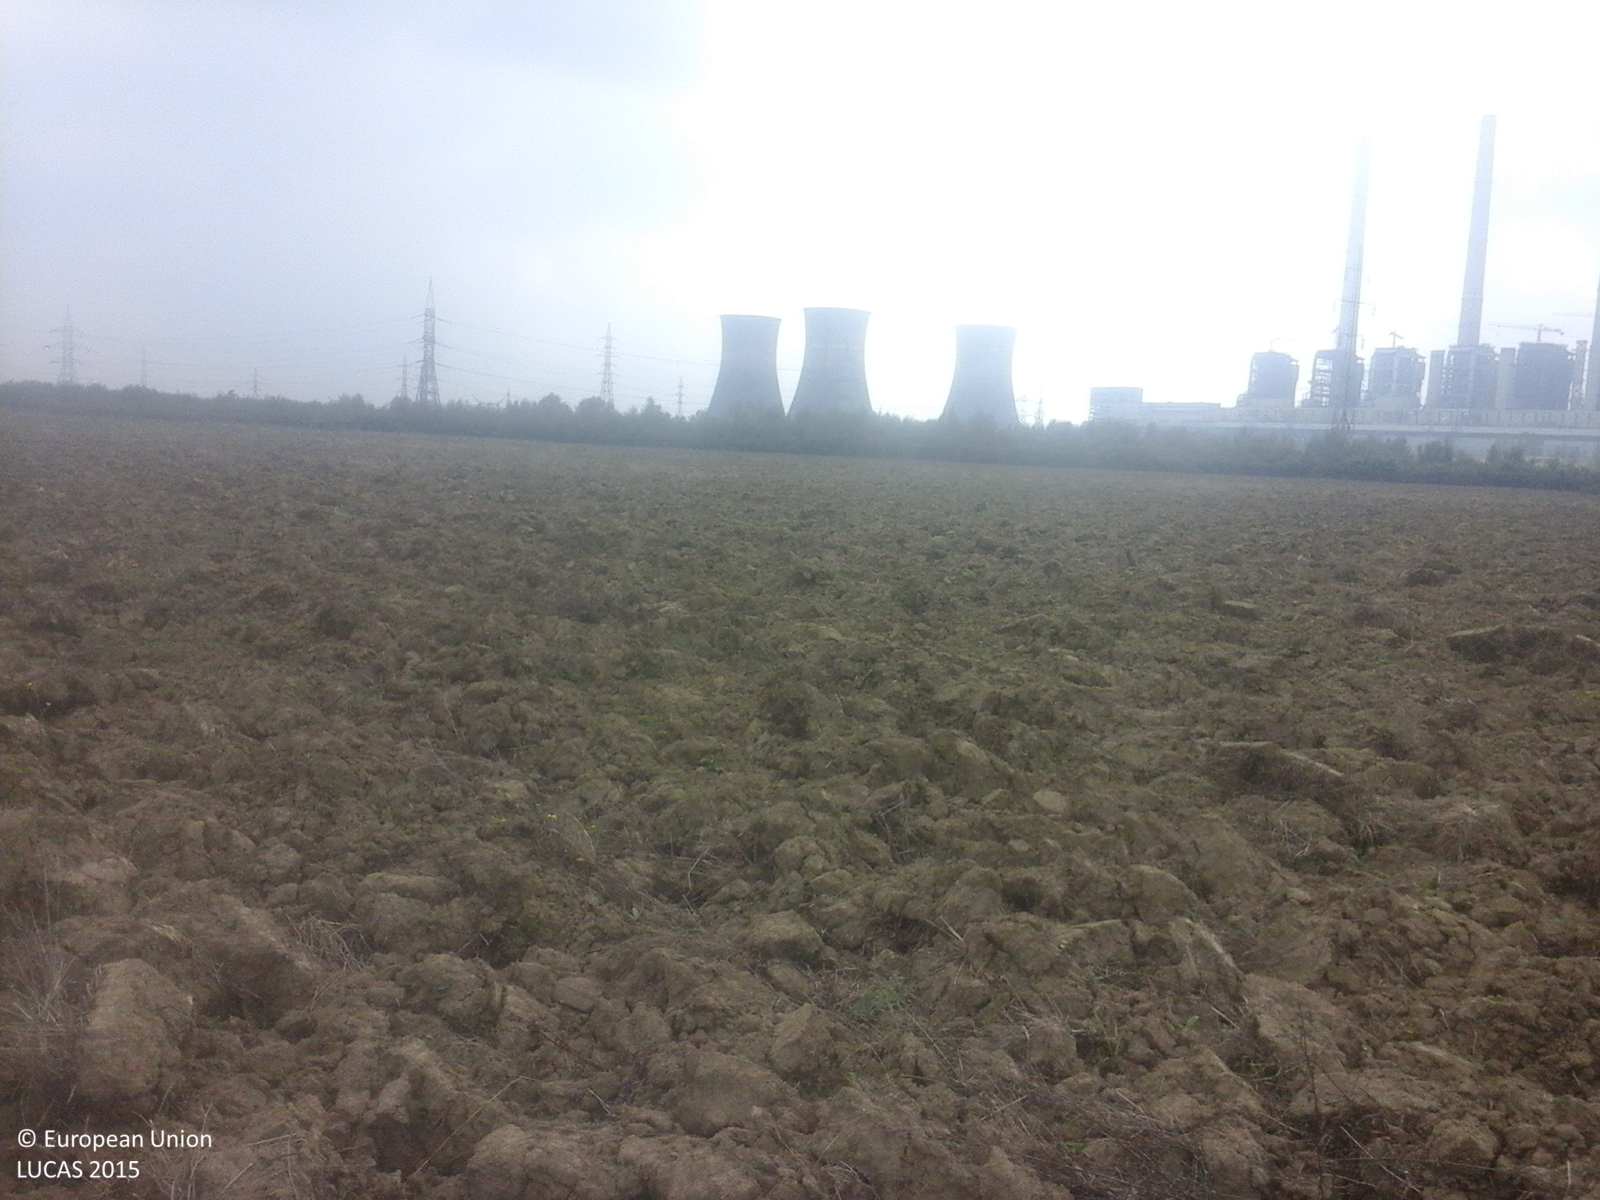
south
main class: Grassland
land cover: Grassland without tree/shrub cover
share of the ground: < 10 %
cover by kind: herbaceous plants 100 %
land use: Agriculture (excluding fallow land and kitchen gardens)
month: September
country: RO
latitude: 44.6804
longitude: 23.4136
